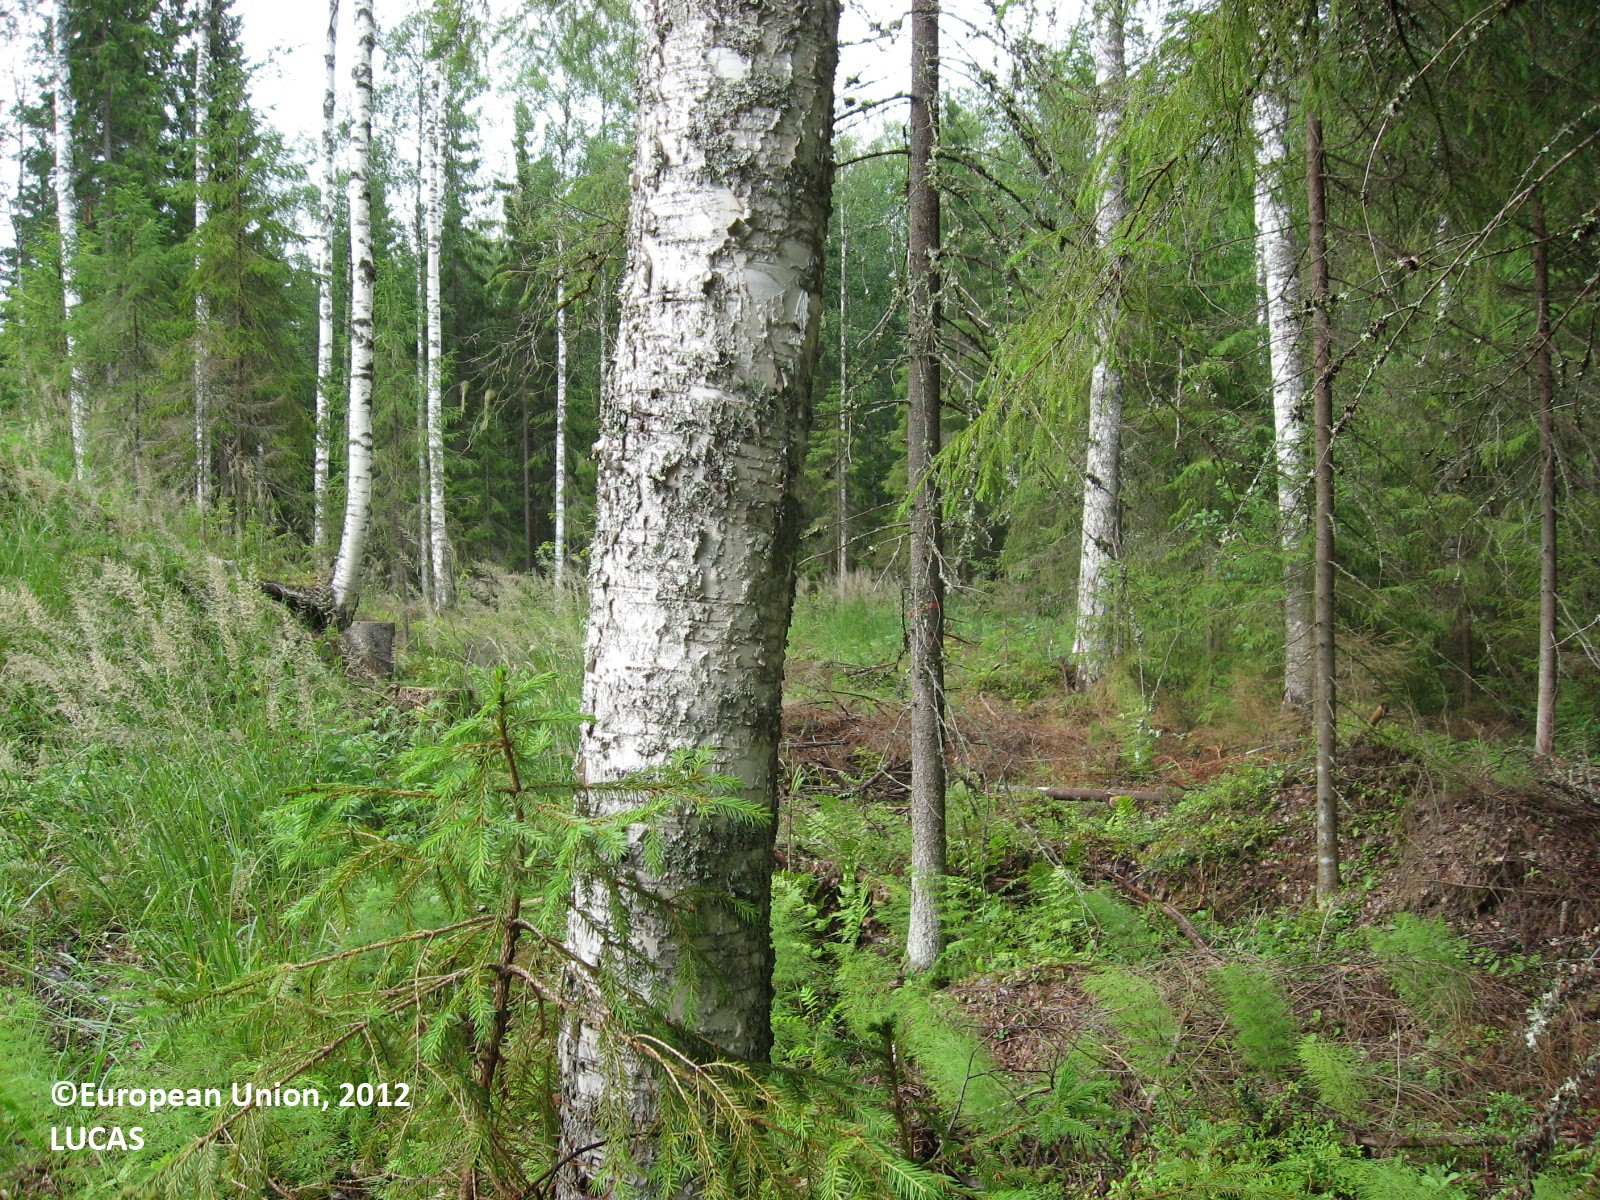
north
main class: Woodland
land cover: Spruce dominated mixed woodland
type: boreal forest
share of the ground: > 75 %
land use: Forestry
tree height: > 5 m
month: July
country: FI
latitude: 61.2741
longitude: 25.7788
